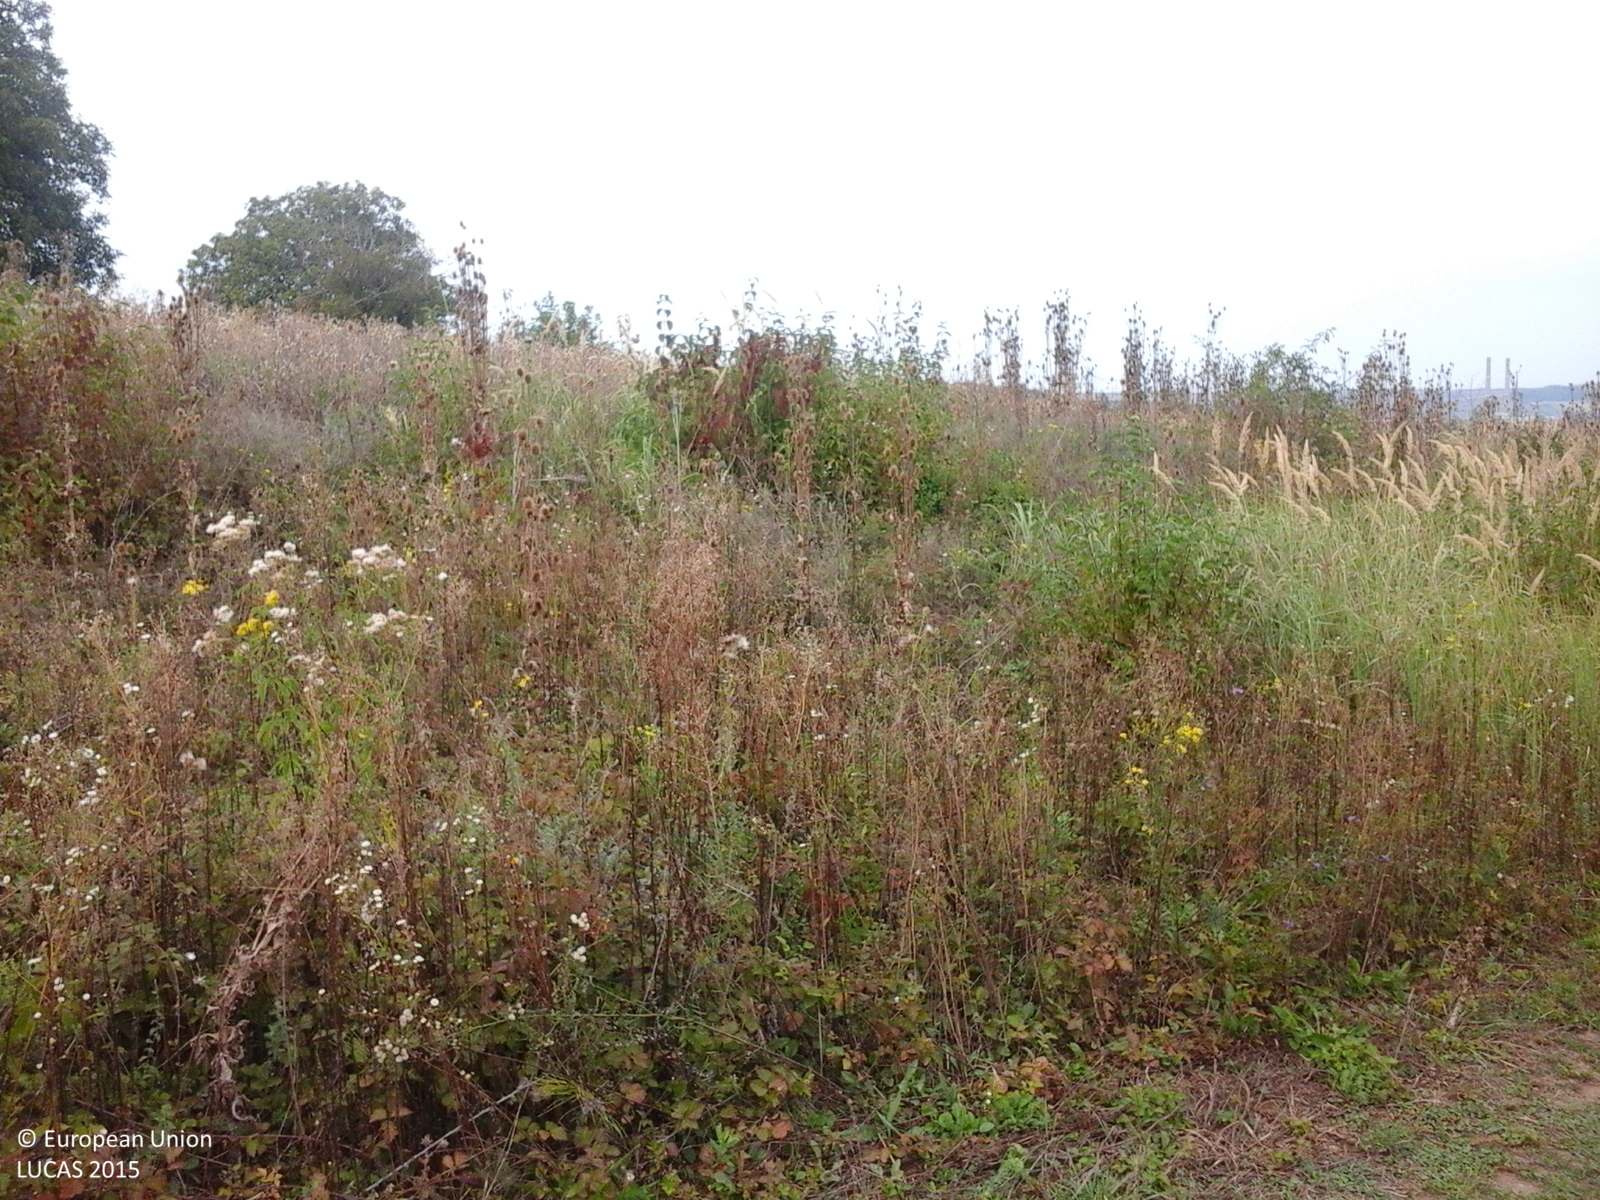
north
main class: Grassland
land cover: Spontaneously vegetated surfaces
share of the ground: > 75 %
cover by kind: herbaceous plants 100 %
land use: Fallow land
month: September
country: RO
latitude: 47.1756
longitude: 23.0070
